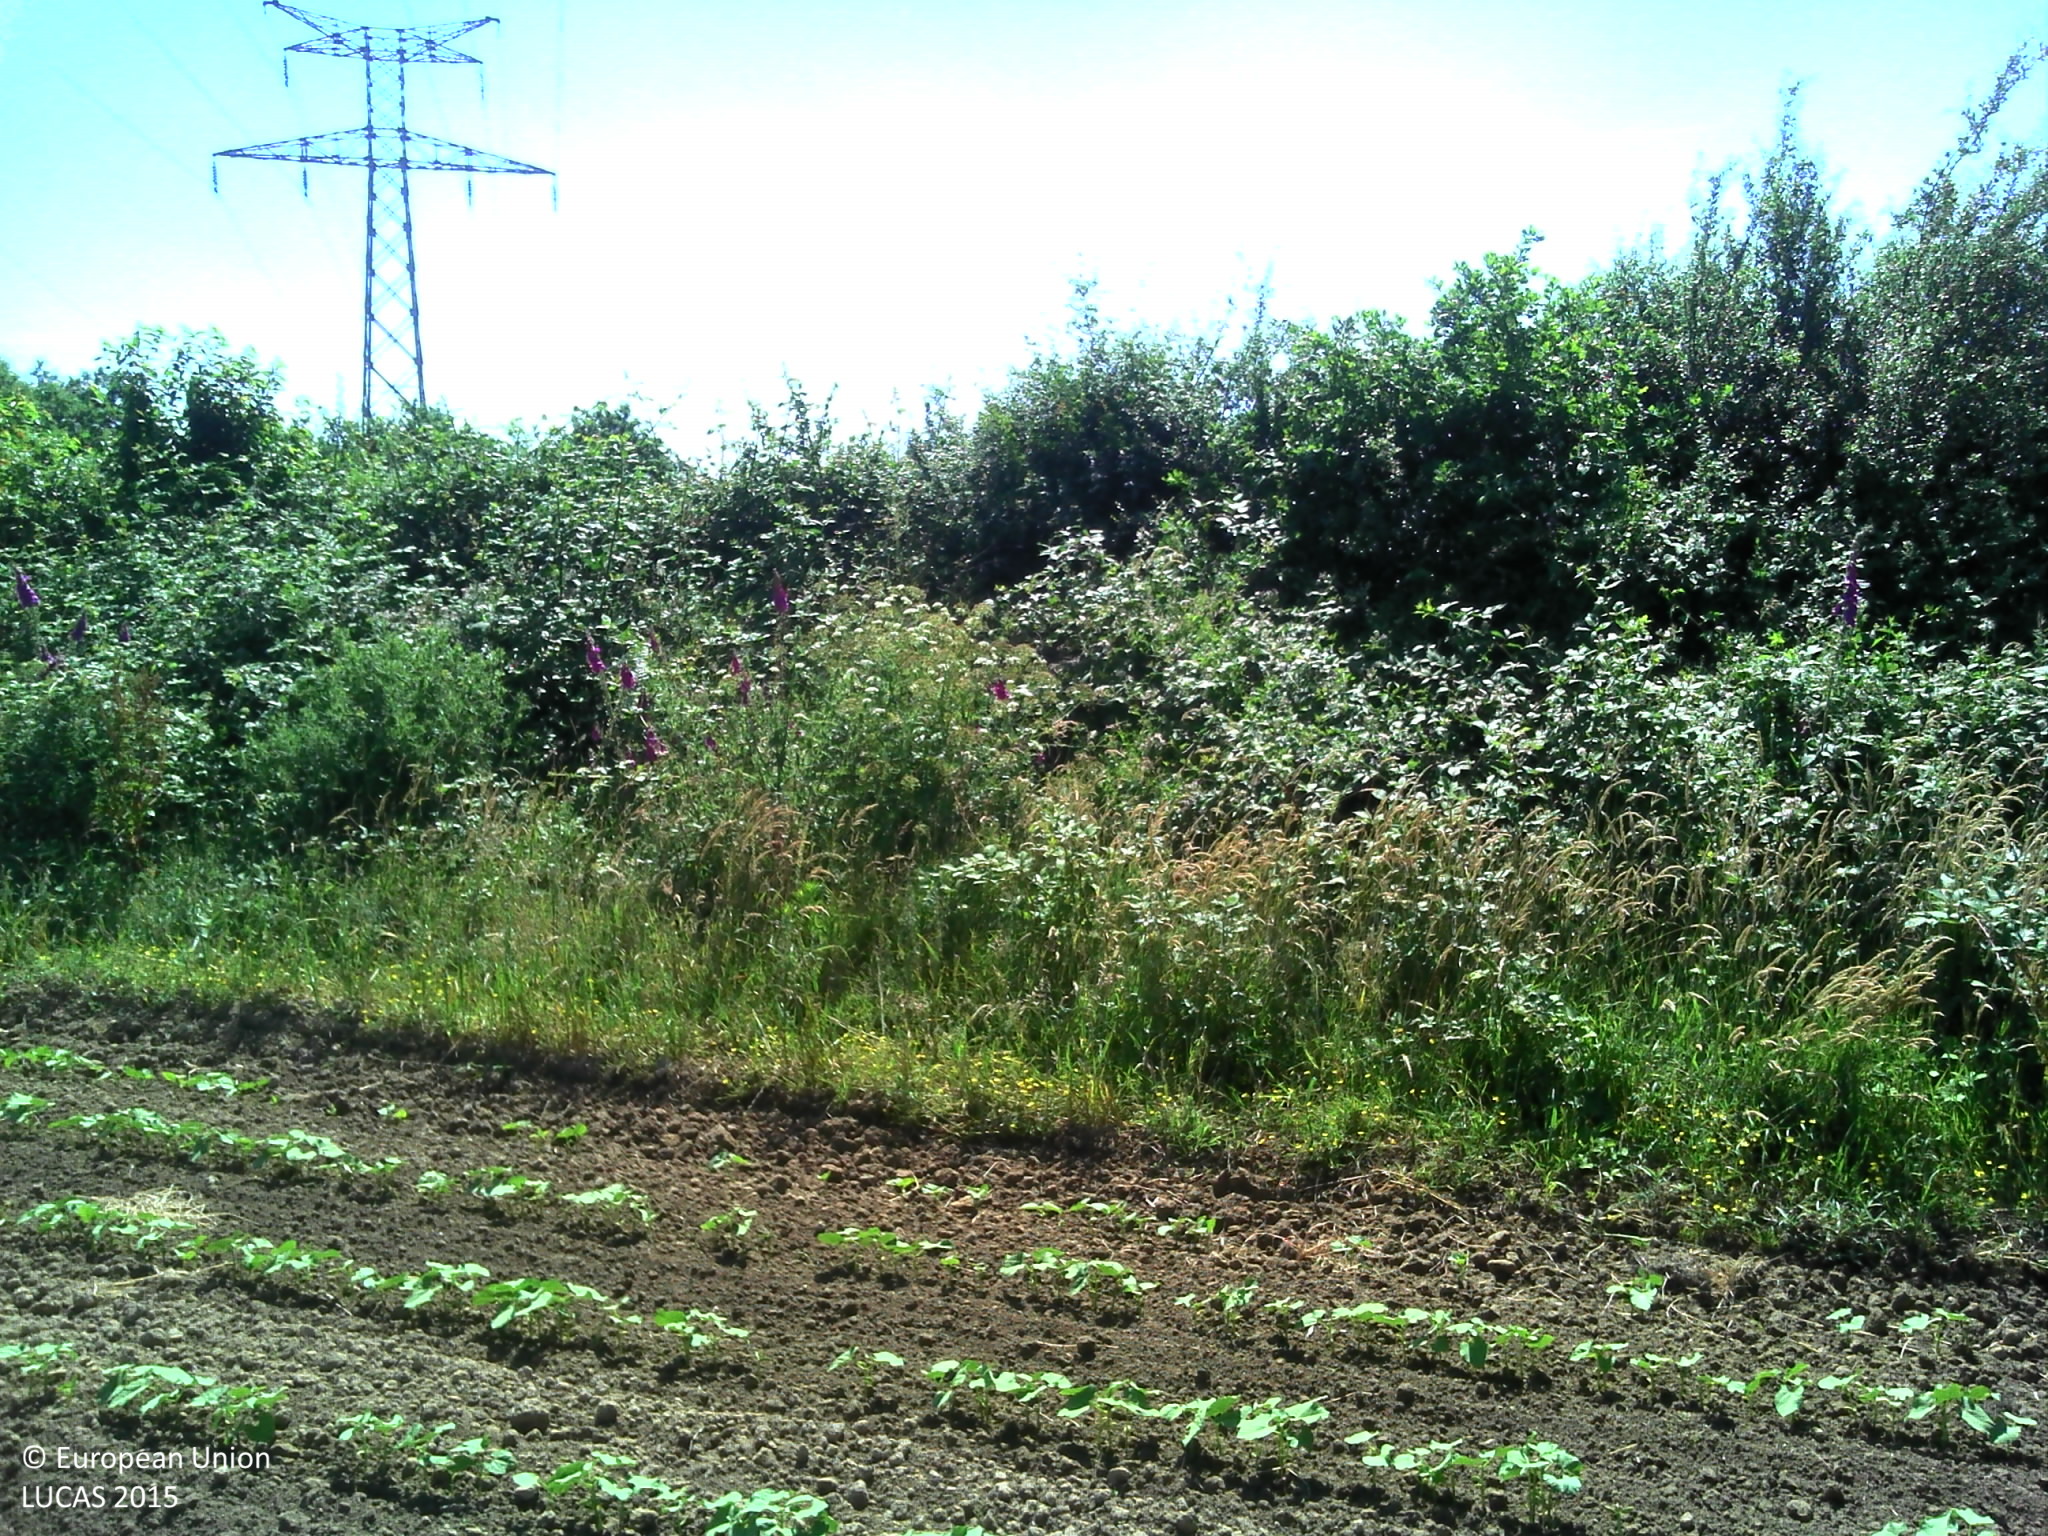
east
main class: Cropland
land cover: Dry pulses
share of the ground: 10 - 25 %
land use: Agriculture (excluding fallow land and kitchen gardens)
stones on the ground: < 10 %
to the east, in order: Dry pulses; Abandoned hedges; Maize; Electric lines; Maize; Lines of trees; Ditches and canals; Grass margins; Paved roads, cycling and walking lanes; Grass margins; Ditches and canals; Fences; Grassland without tree/shrub cover; Electric lines; Grassland without tree/shrub cover
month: June
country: FR
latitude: 46.7916
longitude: -1.4226
